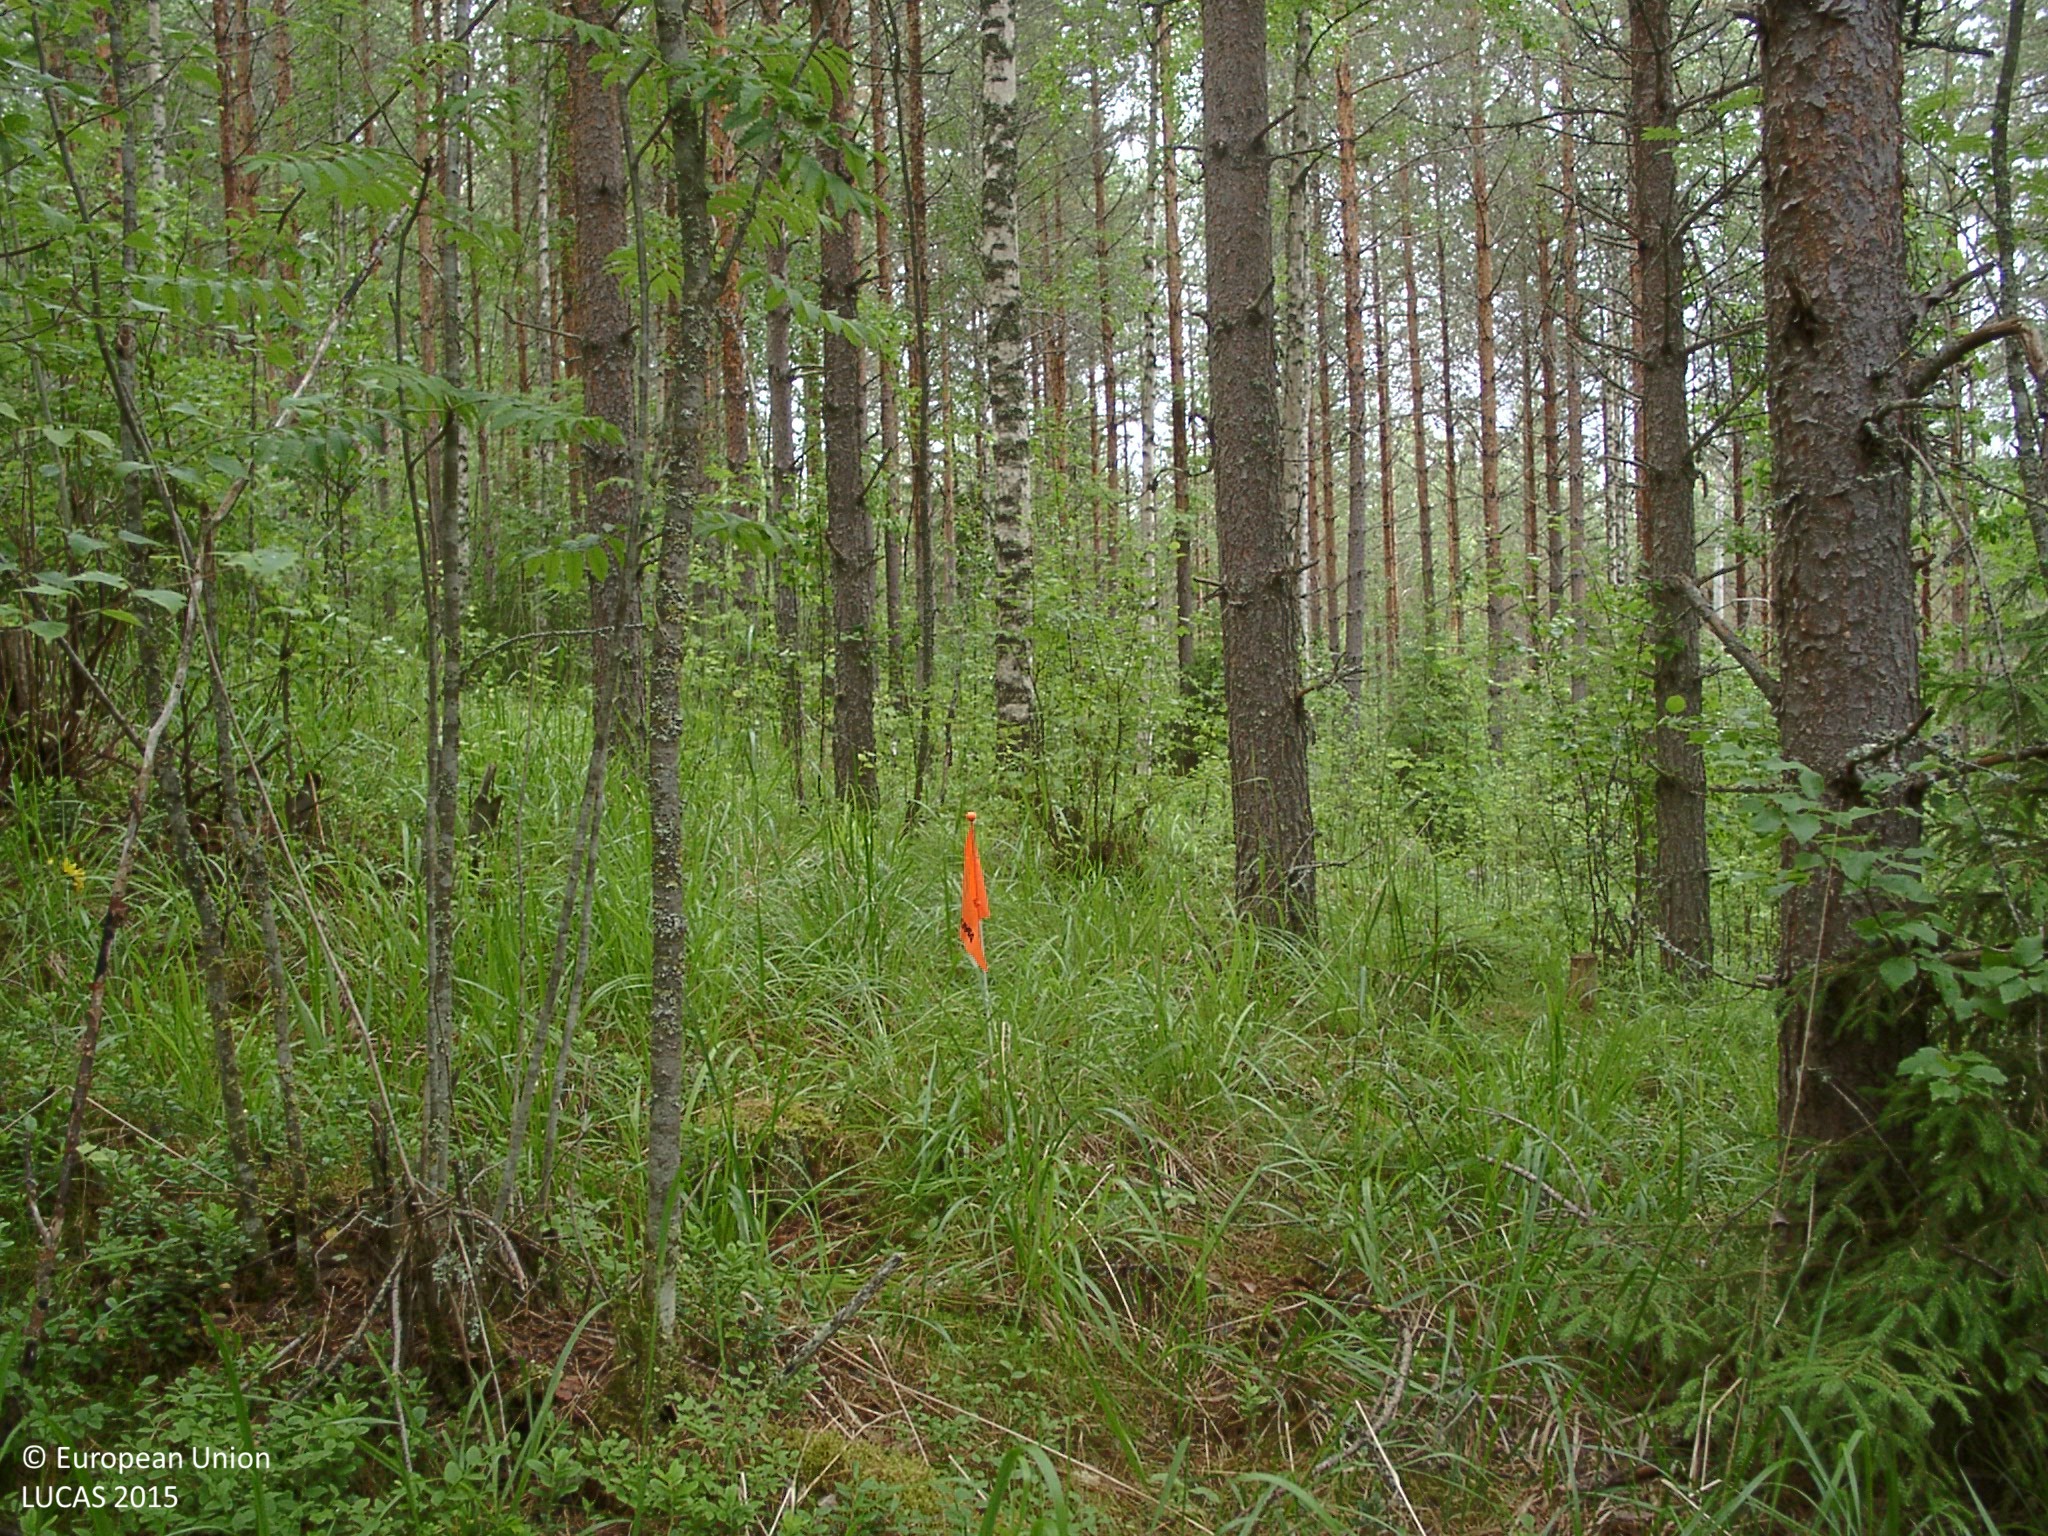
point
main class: Woodland
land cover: Pine dominated mixed woodland
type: boreal forest
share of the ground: 50 - 75 %
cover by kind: coniferous forest trees 45 %, broadleaved forest trees 25 %, shrubs 15 %, herbaceous plants 15 %
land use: Forestry
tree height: > 5 m
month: July
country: FI
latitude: 62.1134
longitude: 25.3481
